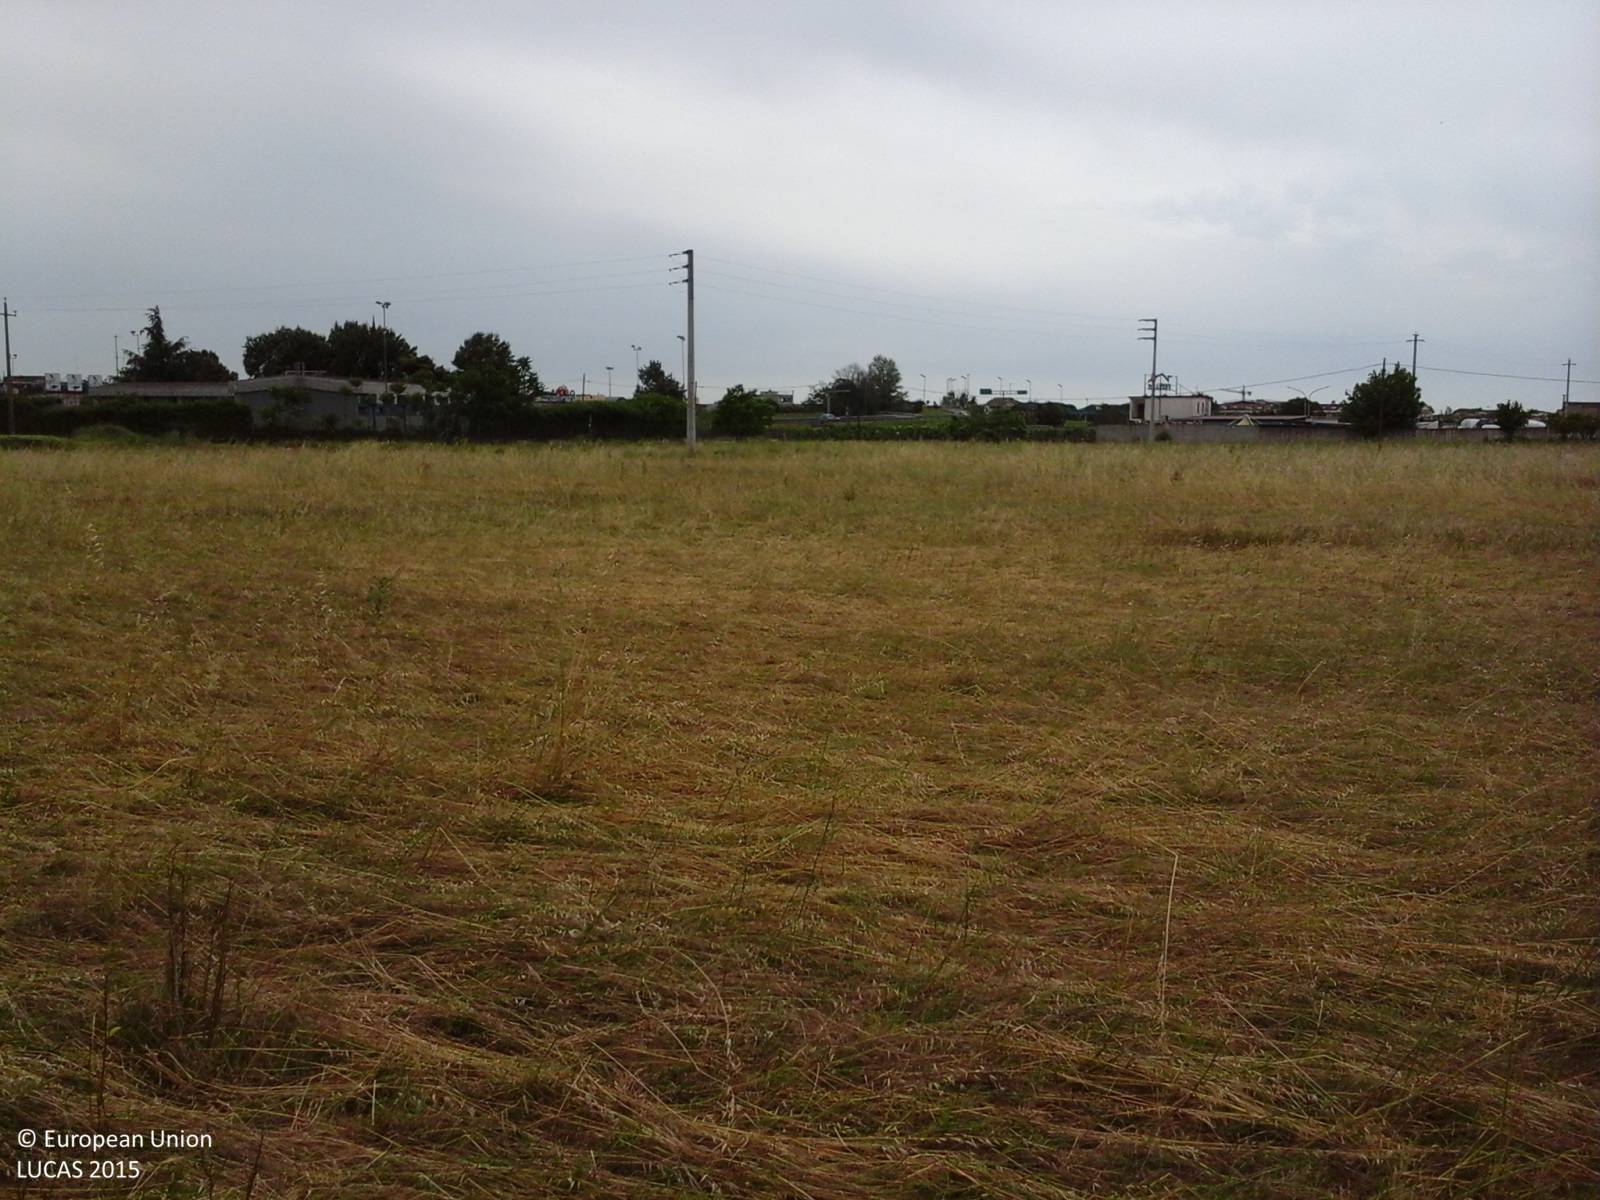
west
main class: Shrubland
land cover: Shrubland without tree cover
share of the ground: 50 - 75 %
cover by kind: herbaceous plants 70 %, shrubs 30 %
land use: Semi-natural and natural areas not in use
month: May
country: IT
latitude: 41.0787
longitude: 14.3035
